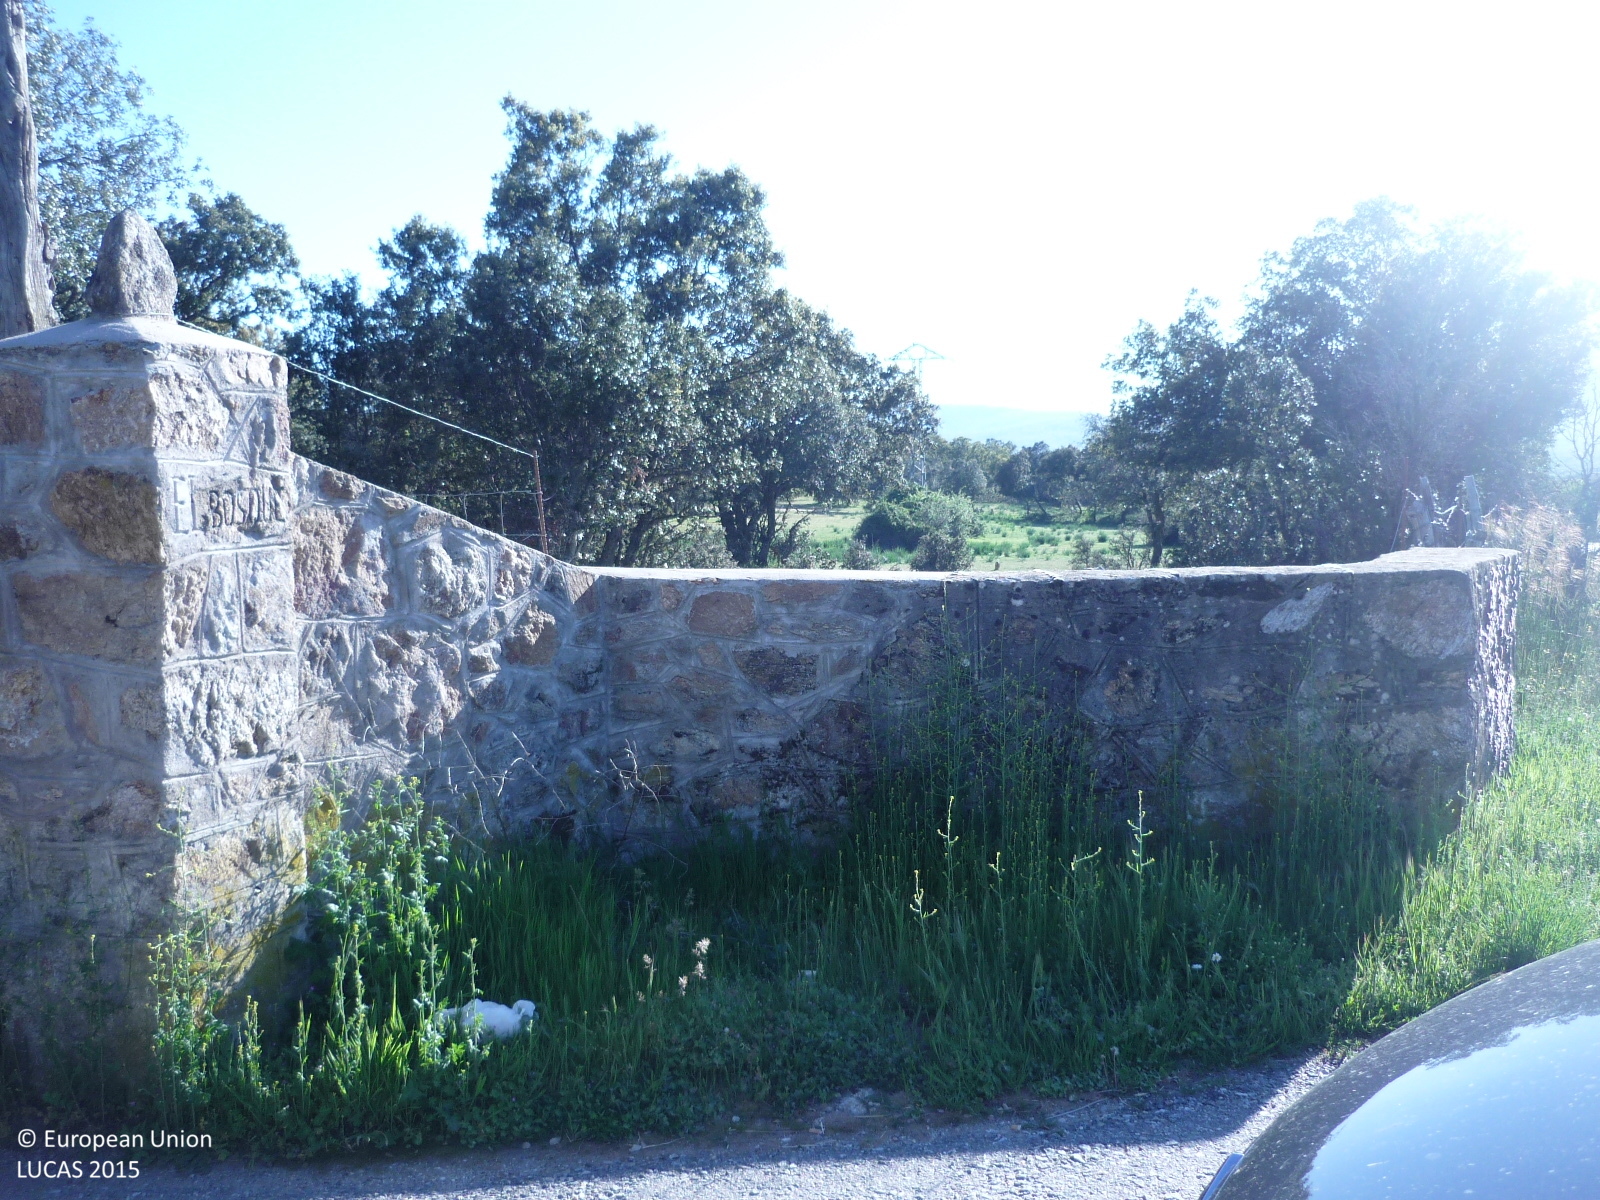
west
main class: Woodland
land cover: Broadleaved woodland
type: broadleaved evergreen forest
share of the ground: > 75 %
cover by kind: broadleaved forest trees 85 %, shrubs 10 %, herbaceous plants 5 %
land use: Forestry
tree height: > 5 m
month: May
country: ES
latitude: 40.9957
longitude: -3.6315
